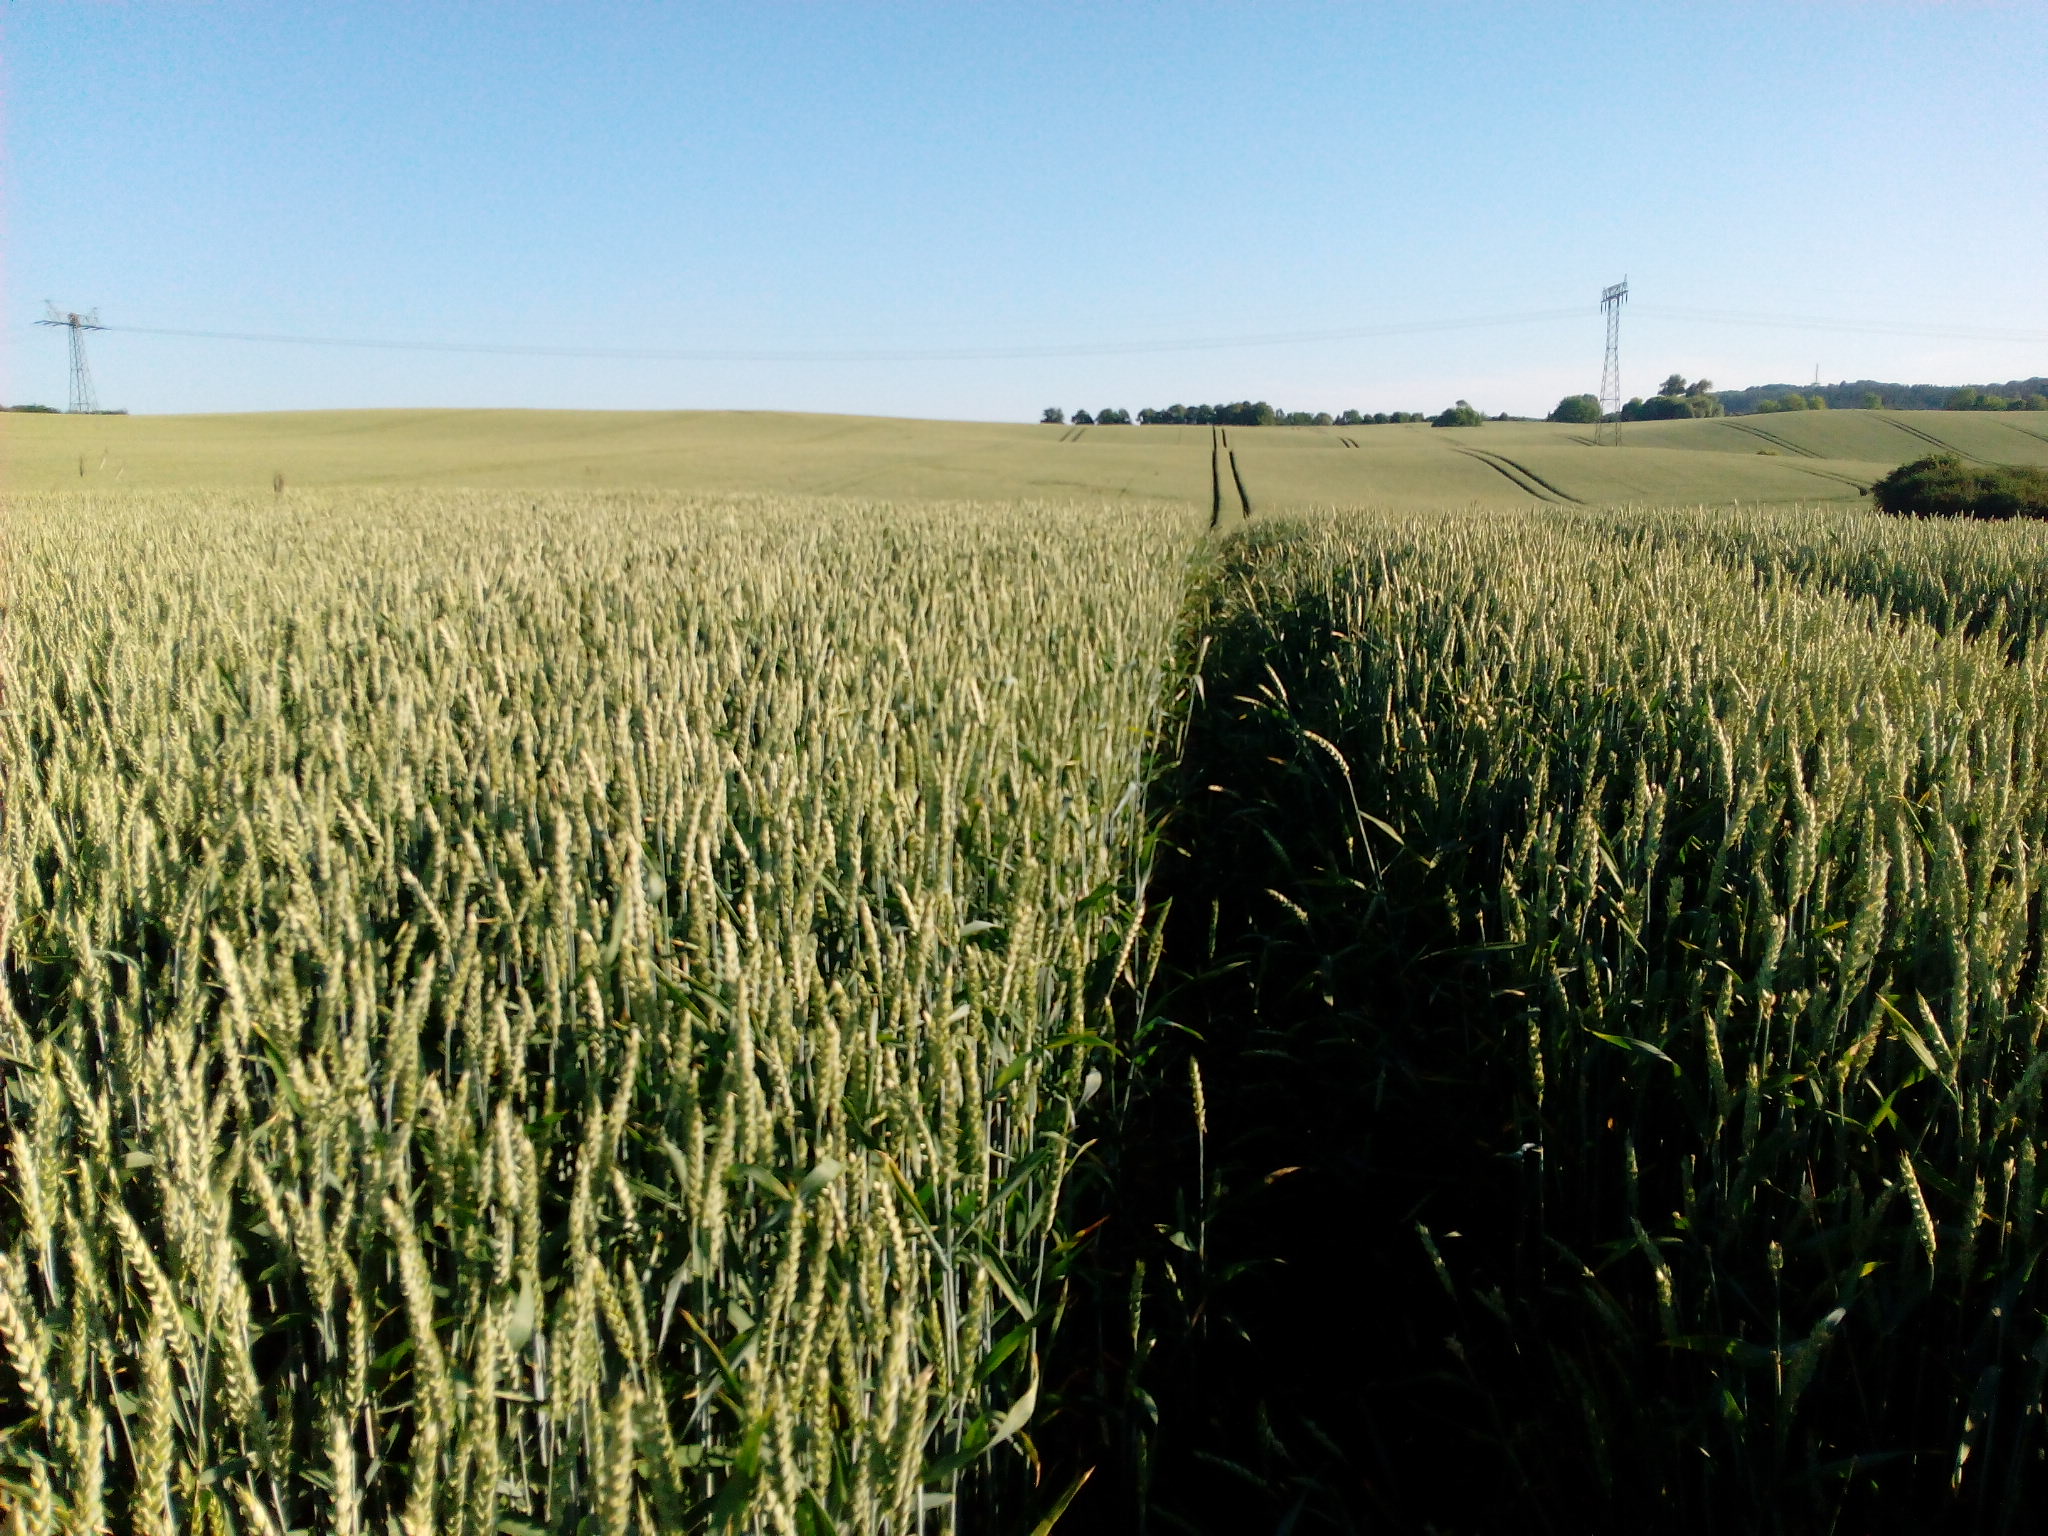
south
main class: Cropland
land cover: Common wheat
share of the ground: > 75 %
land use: Agriculture (excluding fallow land and kitchen gardens)
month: July
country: DE
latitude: 53.4315
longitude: 13.2055
